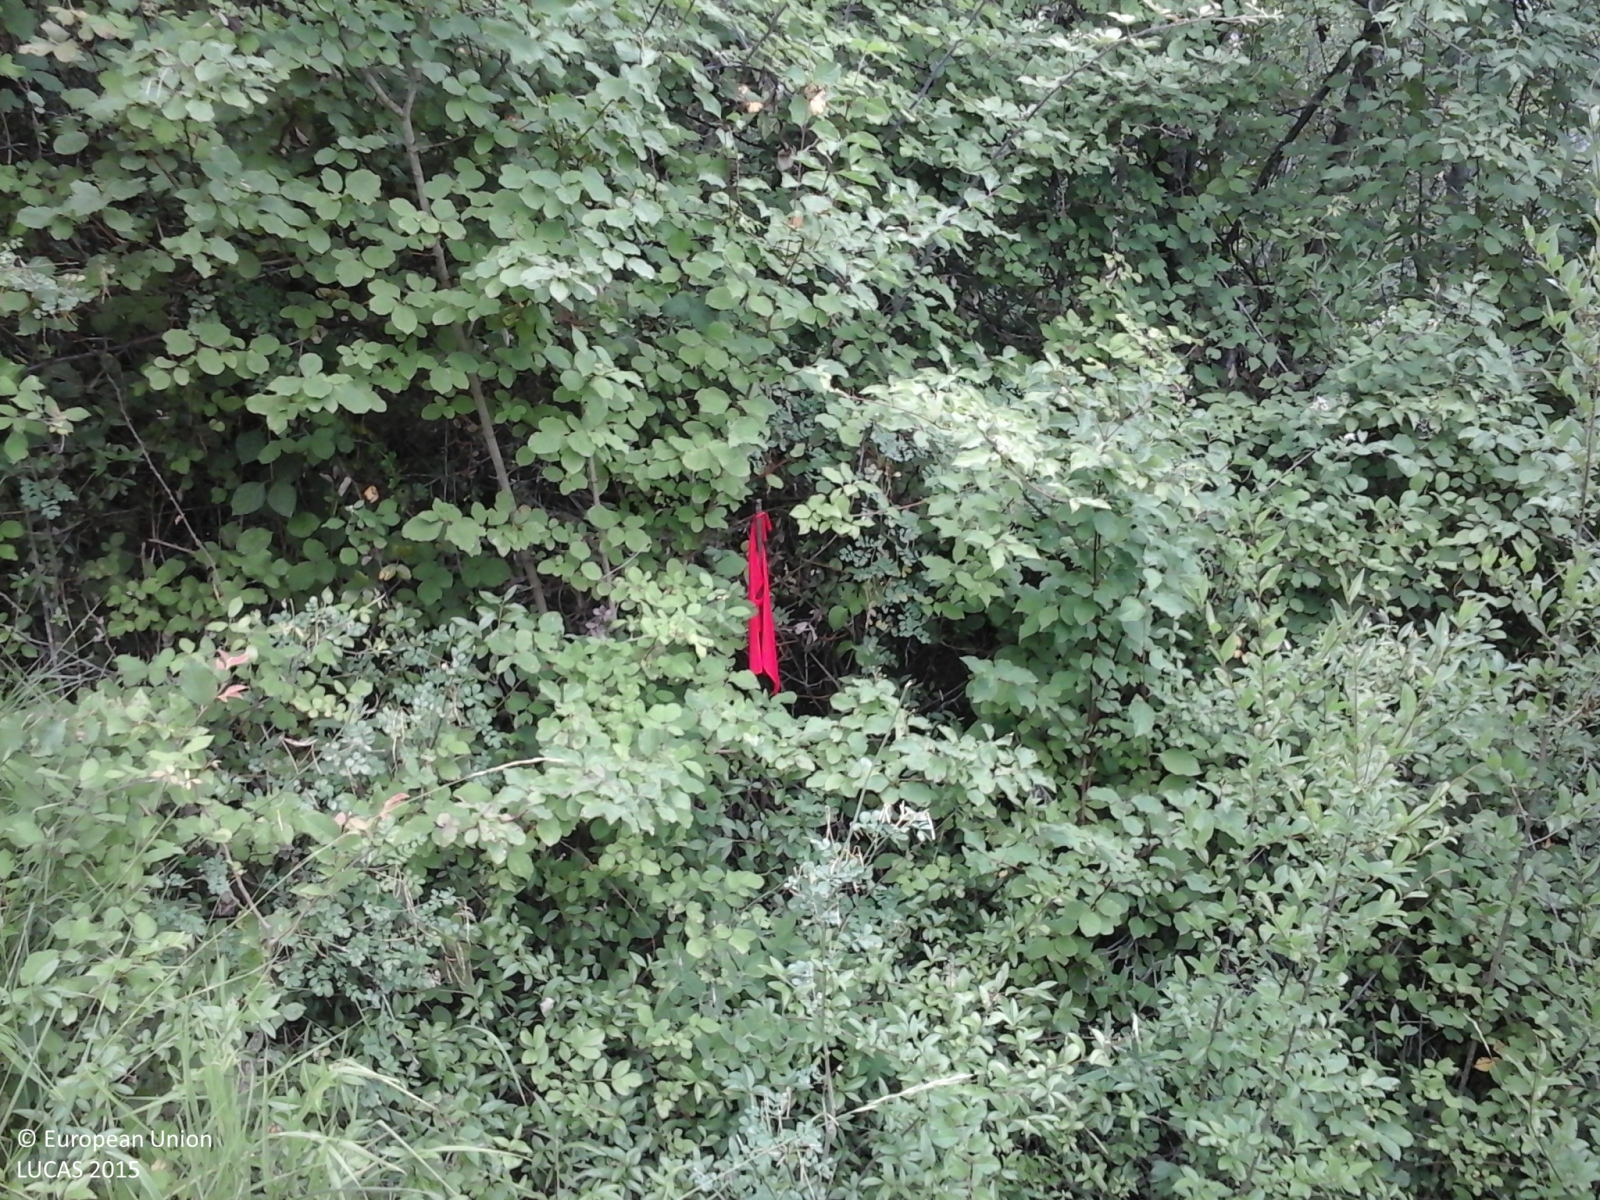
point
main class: Shrubland
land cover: Shrubland with sparse tree cover
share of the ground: > 75 %
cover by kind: shrubs 90 %, broadleaved forest trees 5 %, herbaceous plants 5 %
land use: Semi-natural and natural areas not in use
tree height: < 5 m
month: June
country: IT
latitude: 42.0954
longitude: 14.2303
